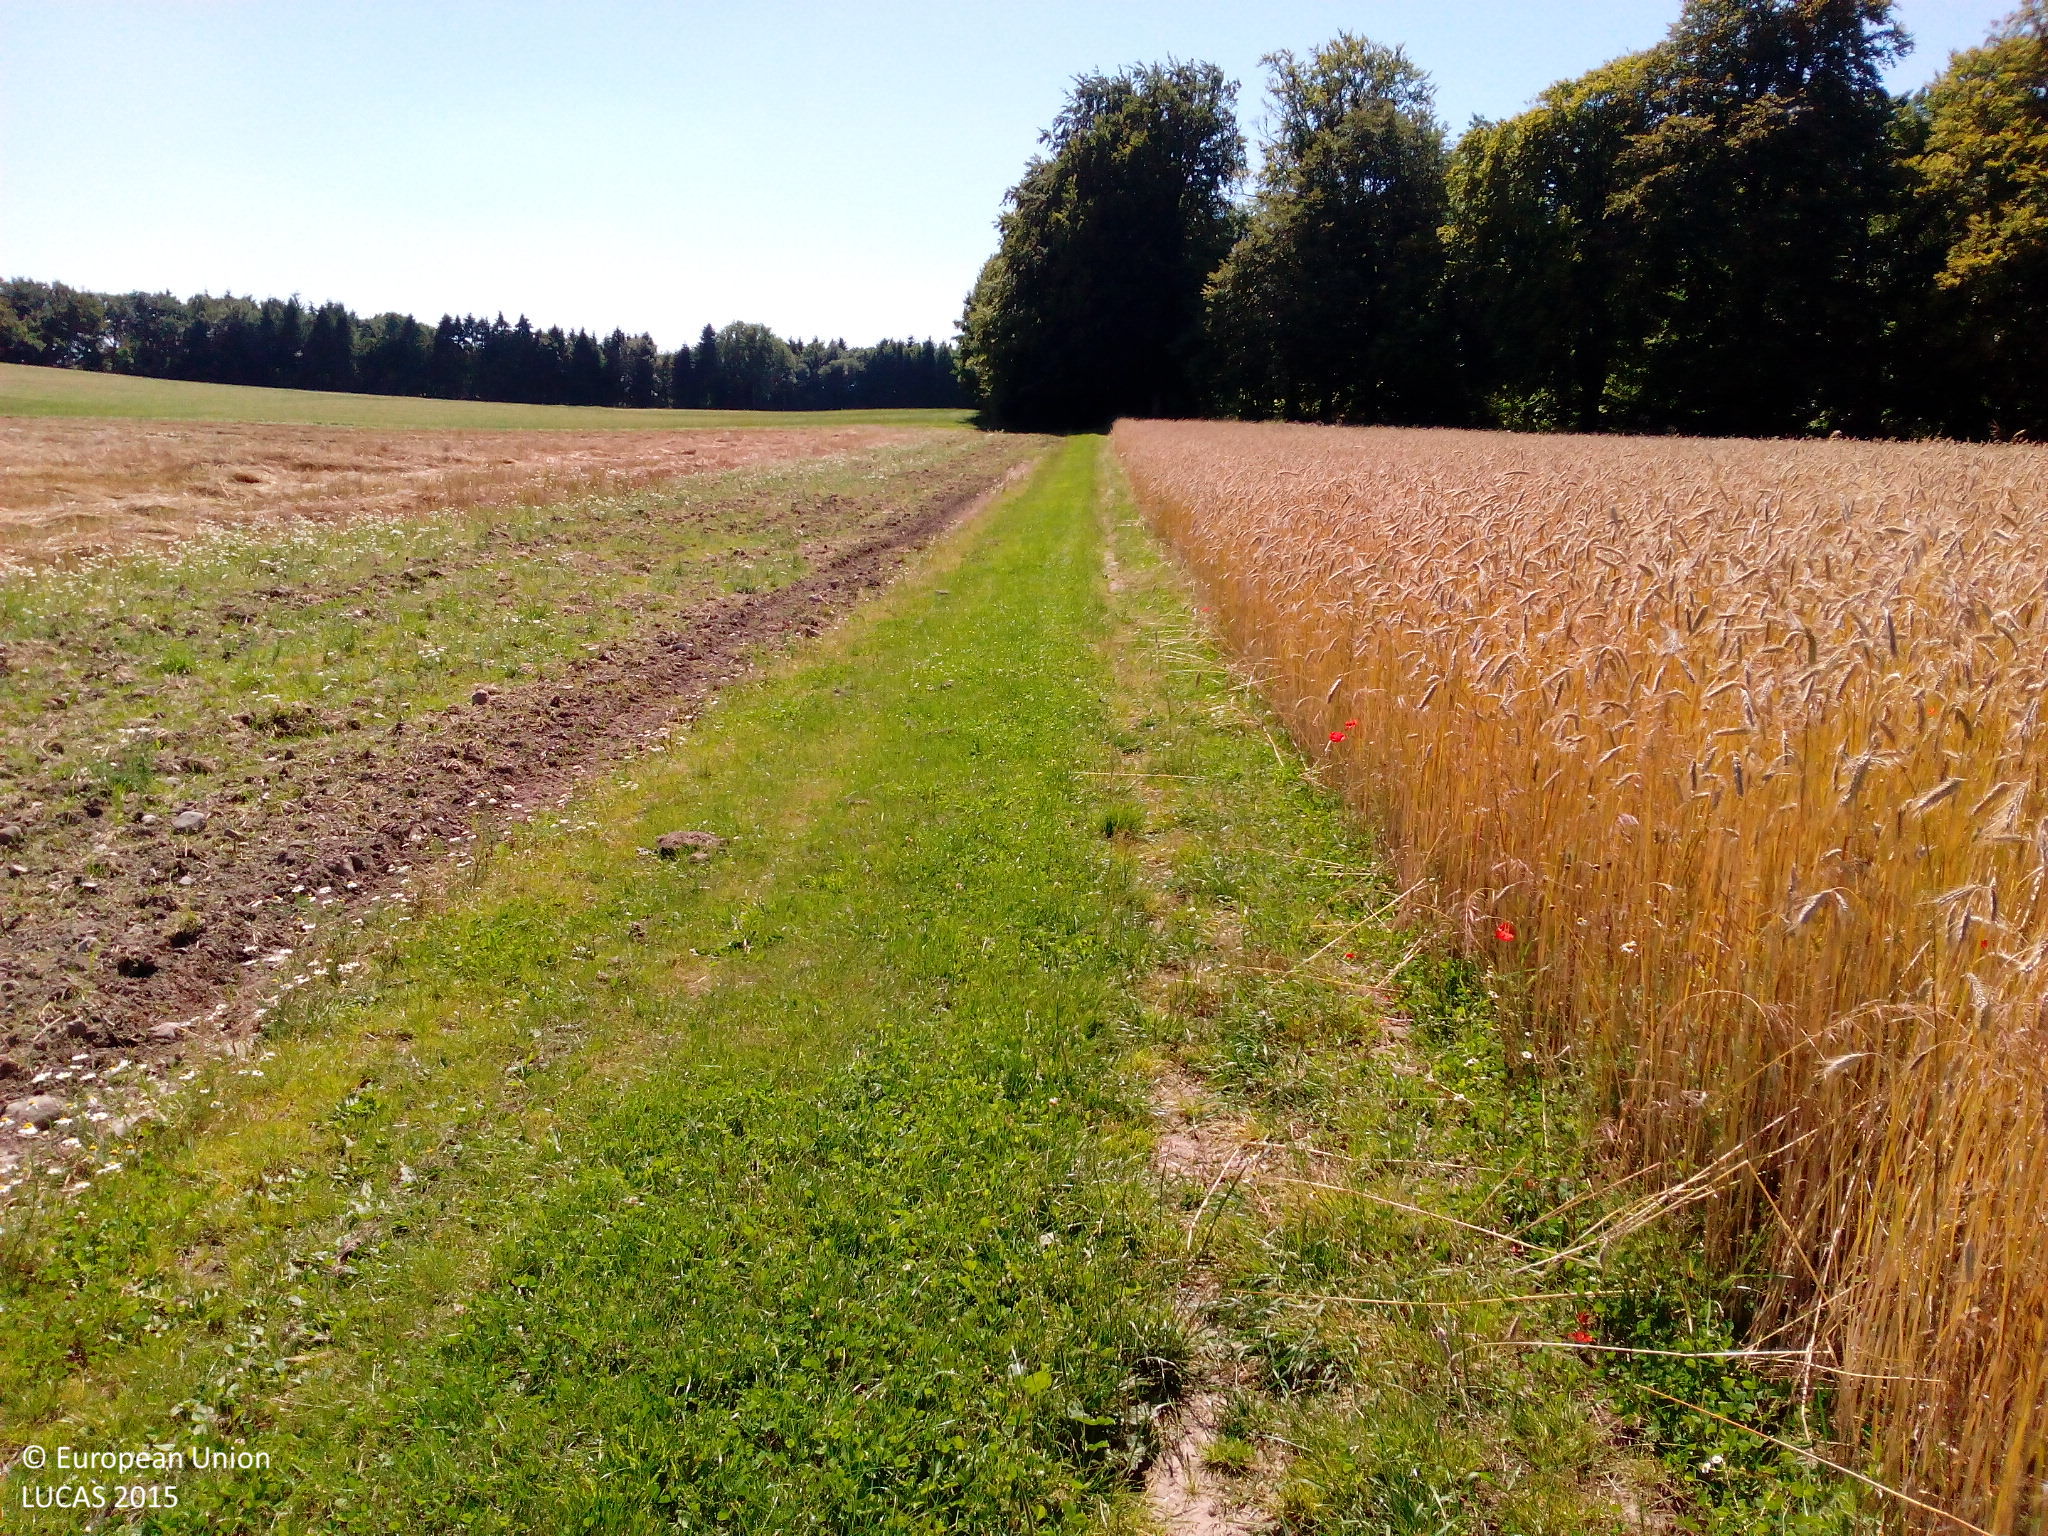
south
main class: Cropland
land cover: Rye
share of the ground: > 75 %
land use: Agriculture (excluding fallow land and kitchen gardens)
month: August
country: DK
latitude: 55.5806
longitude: 11.8861
